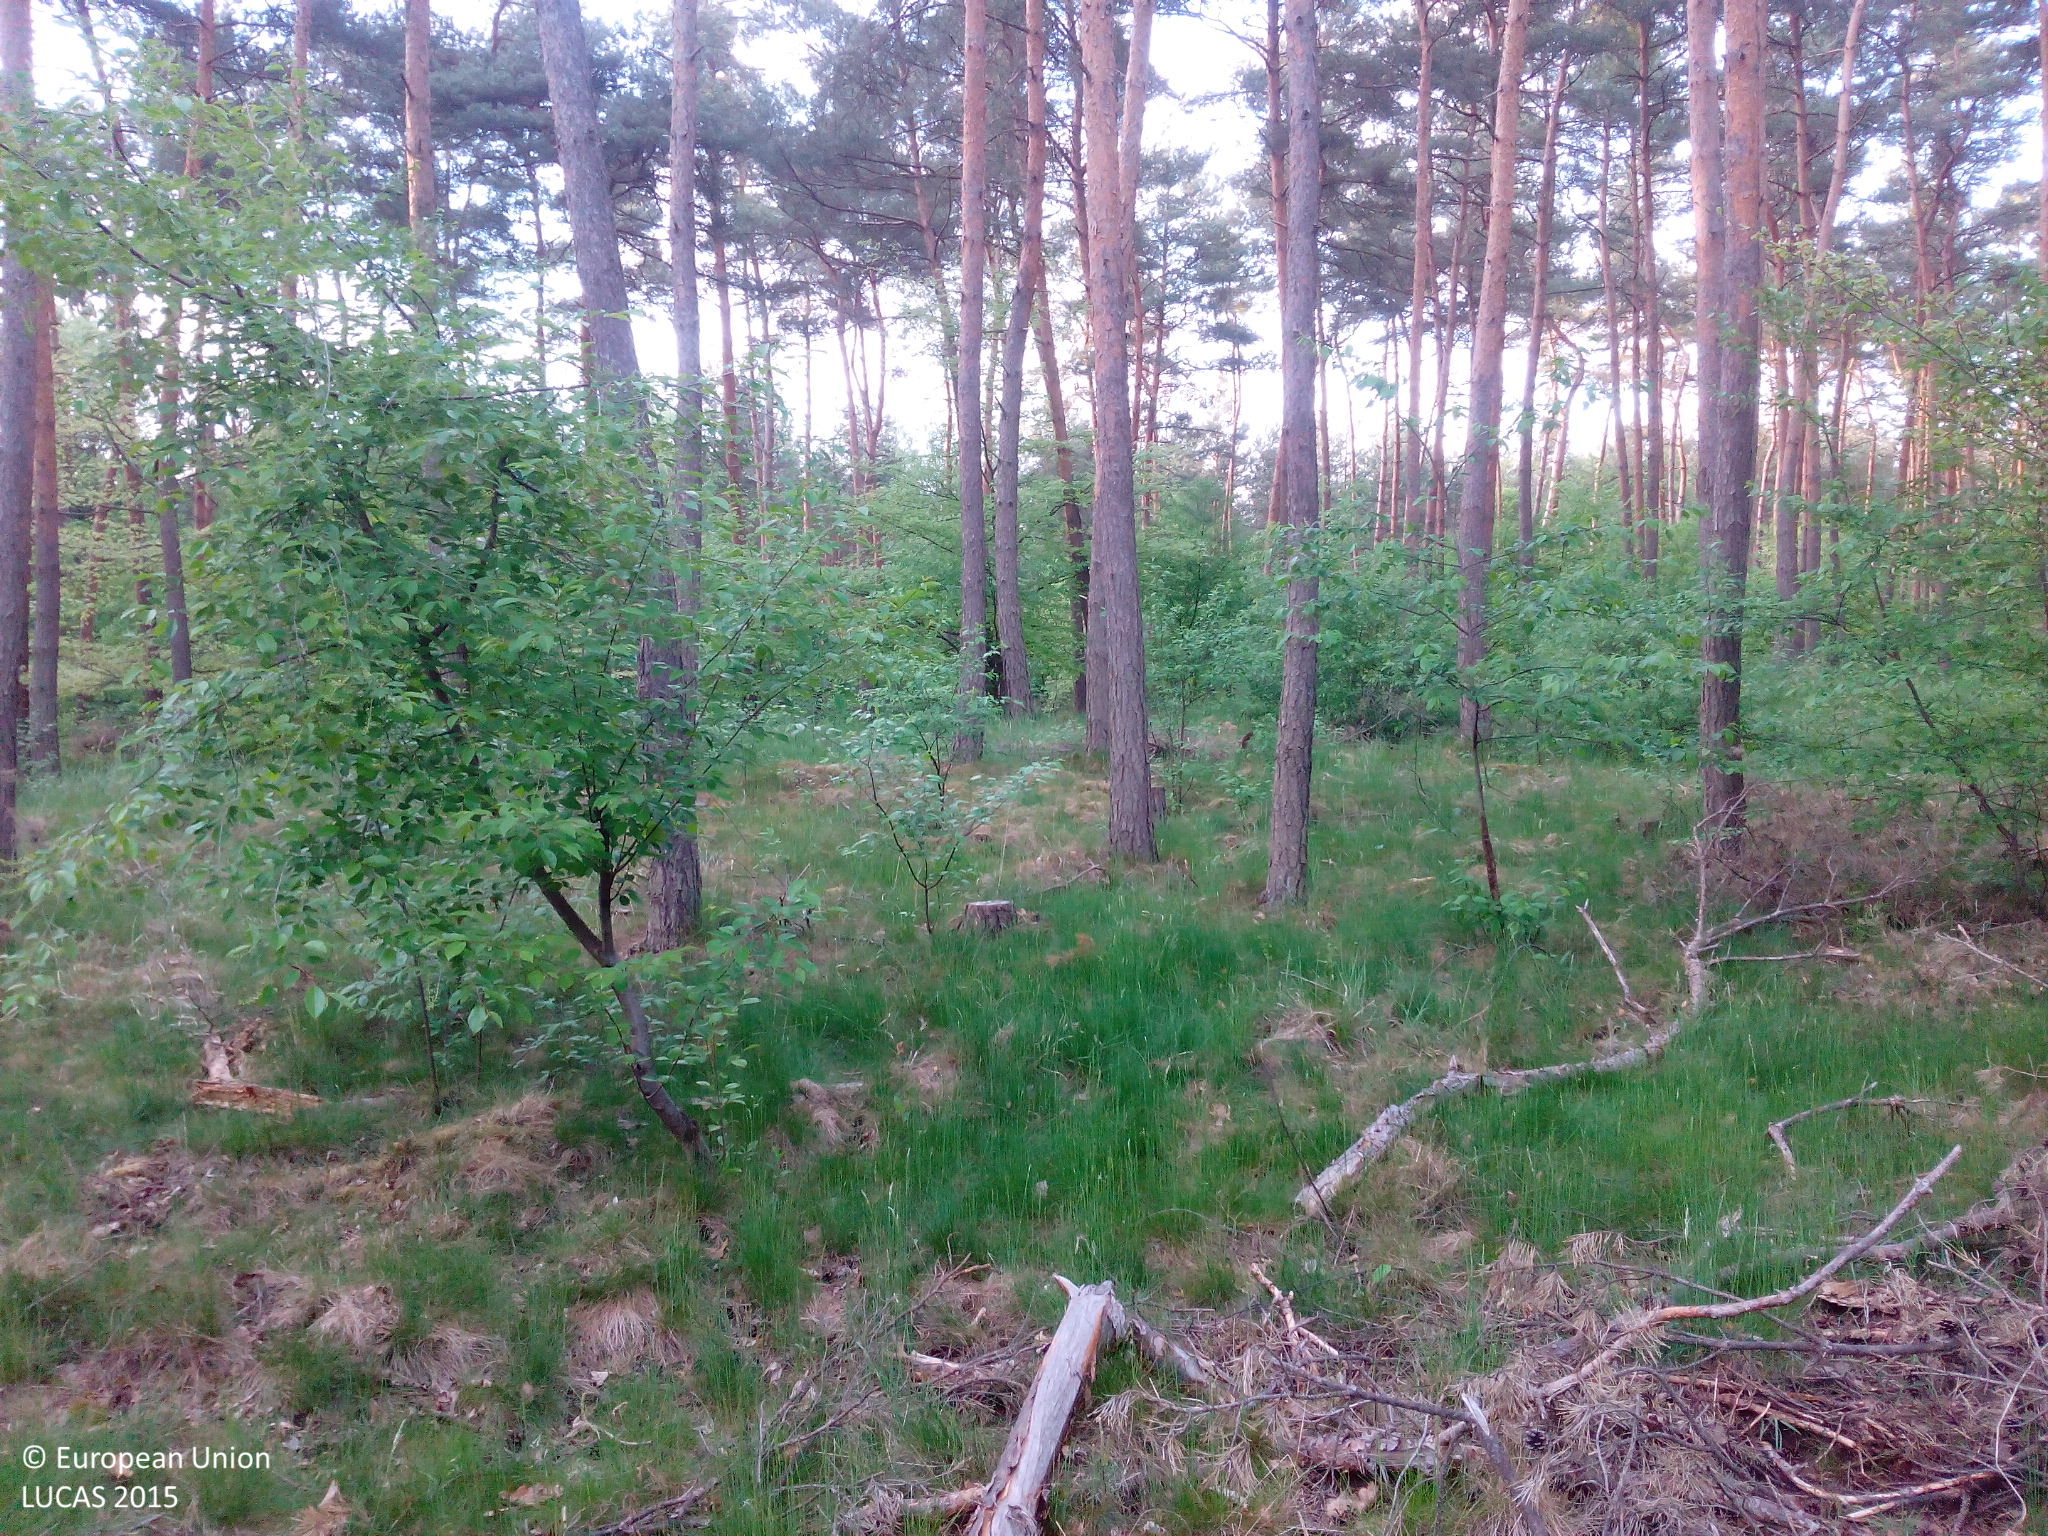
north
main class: Woodland
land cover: Pine dominated coniferous woodland
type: hemiboreal forest and nemoral coniferous forest and mixed broadleaved-coniferous forest
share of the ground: > 75 %
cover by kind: coniferous forest trees 60 %, herbaceous plants 20 %, broadleaved forest trees 15 %, unconsolidated bare surface 5 %
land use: Forestry
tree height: > 5 m
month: May
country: DE
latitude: 49.5994
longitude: 8.5477
